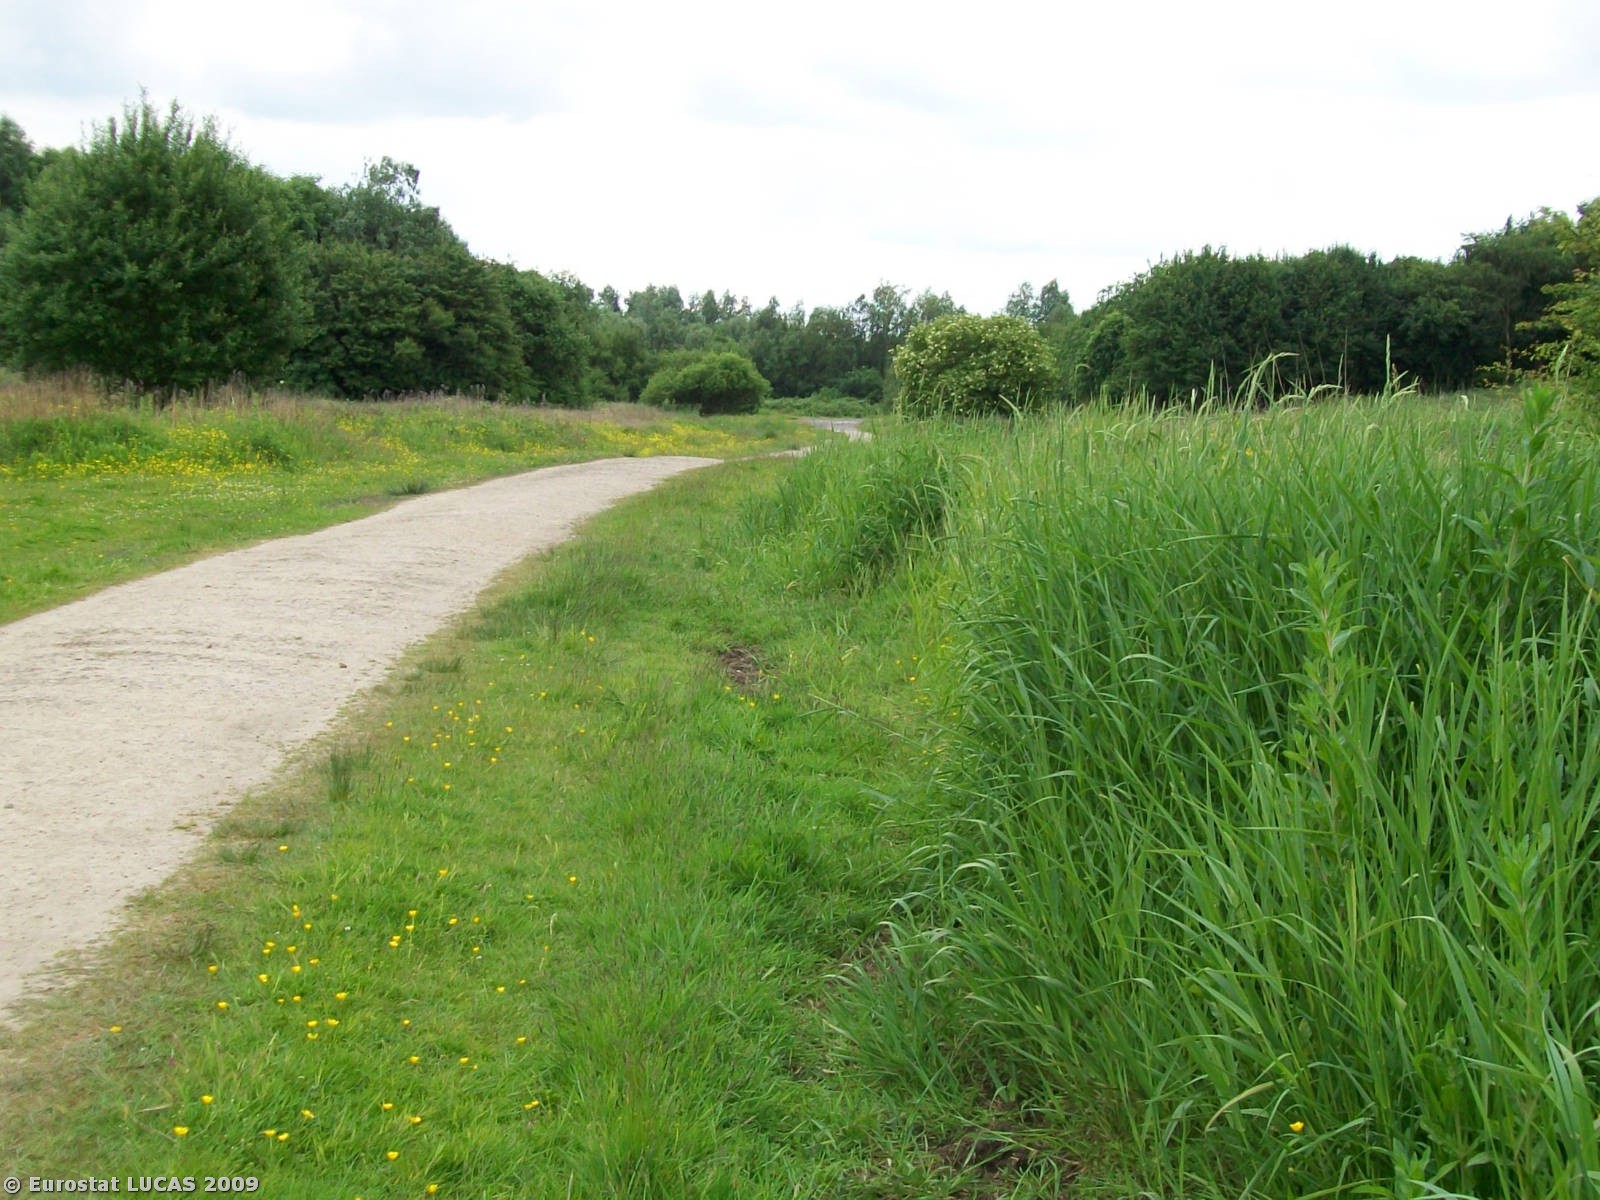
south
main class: Grassland
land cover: Grassland with sparse tree/shrub cover
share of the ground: < 10 %
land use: Amenities, museums, leisure
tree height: > 5 m
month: June
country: GB
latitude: 53.4099
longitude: -2.8128
